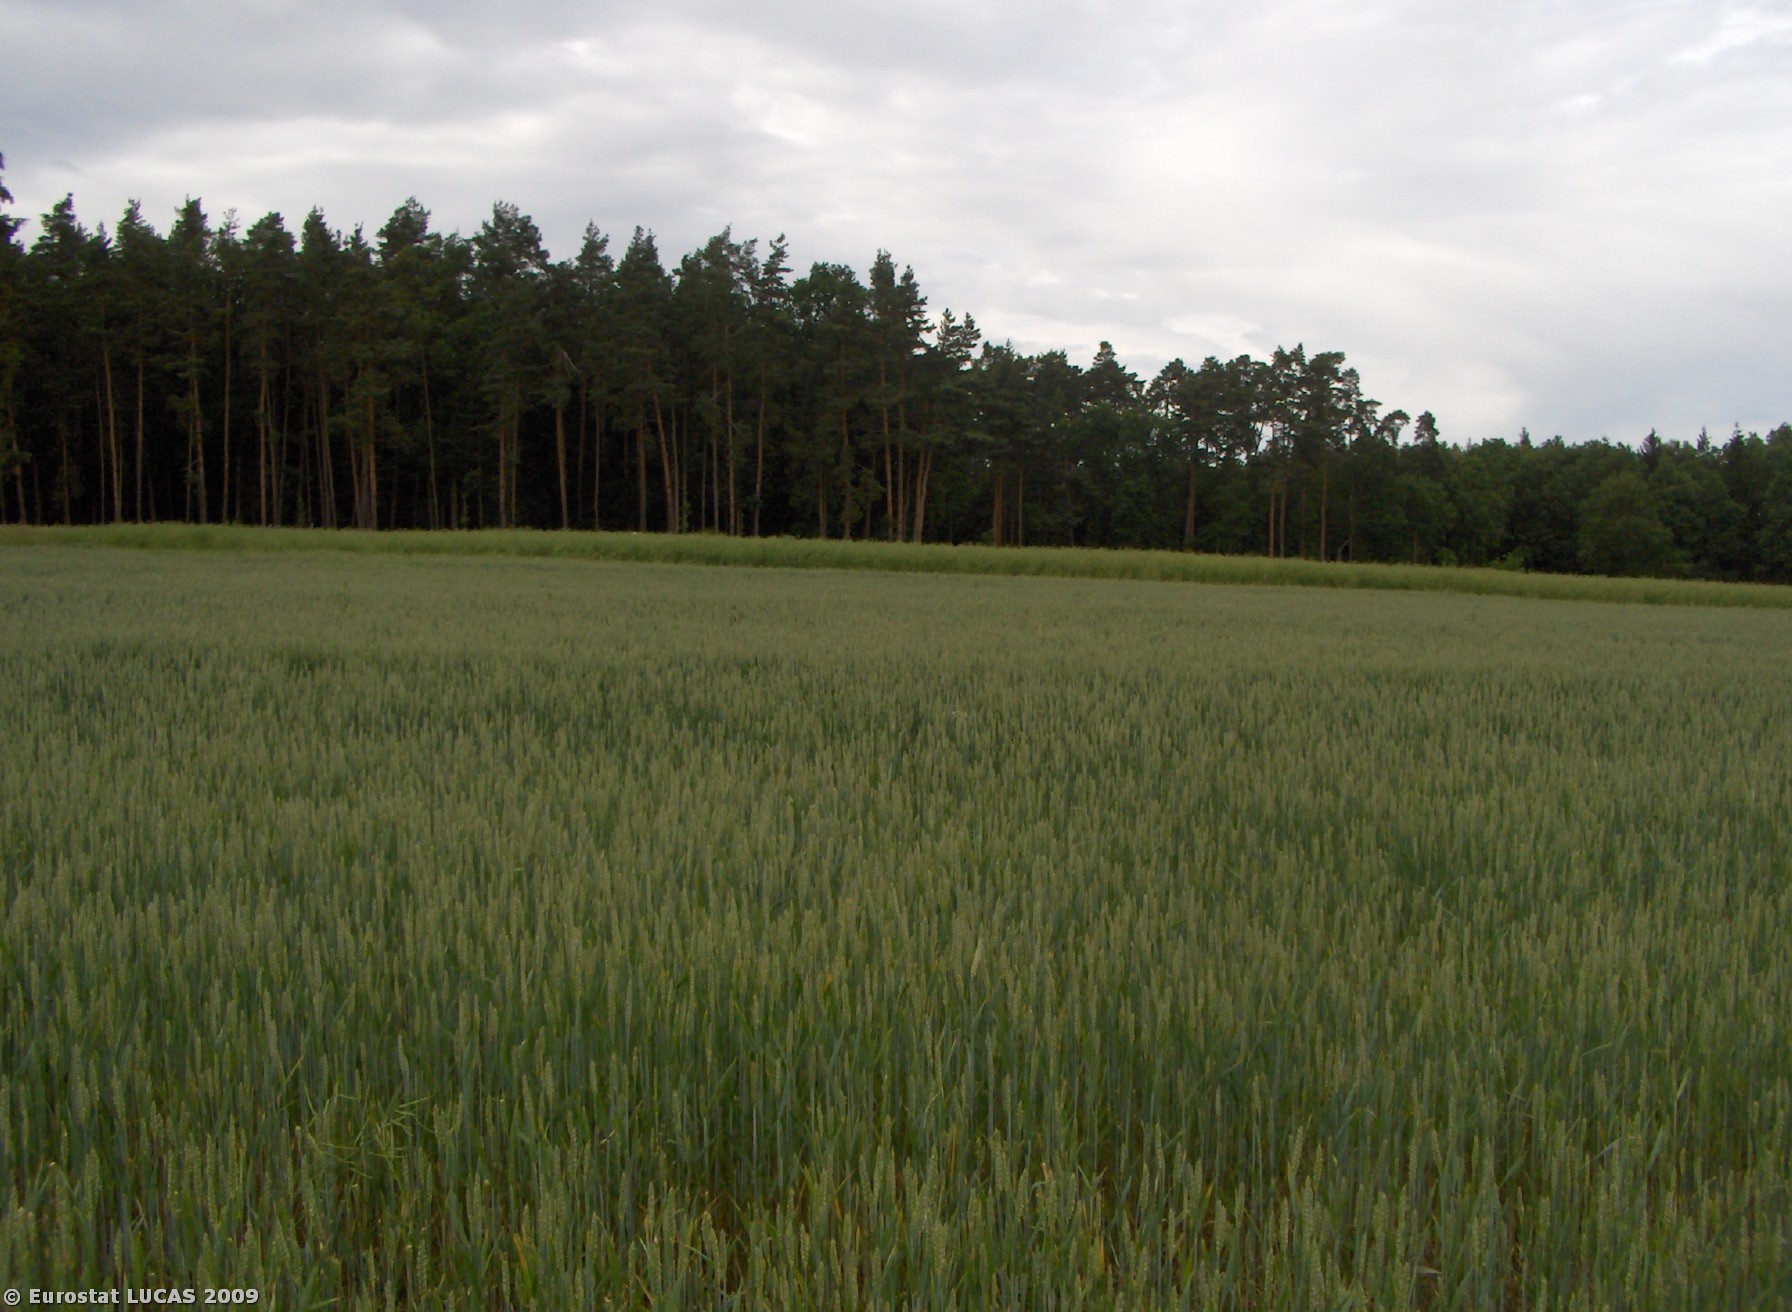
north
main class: Cropland
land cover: Rape and turnip rape
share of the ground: > 75 %
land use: Agriculture (excluding fallow land and kitchen gardens)
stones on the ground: < 10 %
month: June
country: CZ
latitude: 49.1299
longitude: 14.3179
